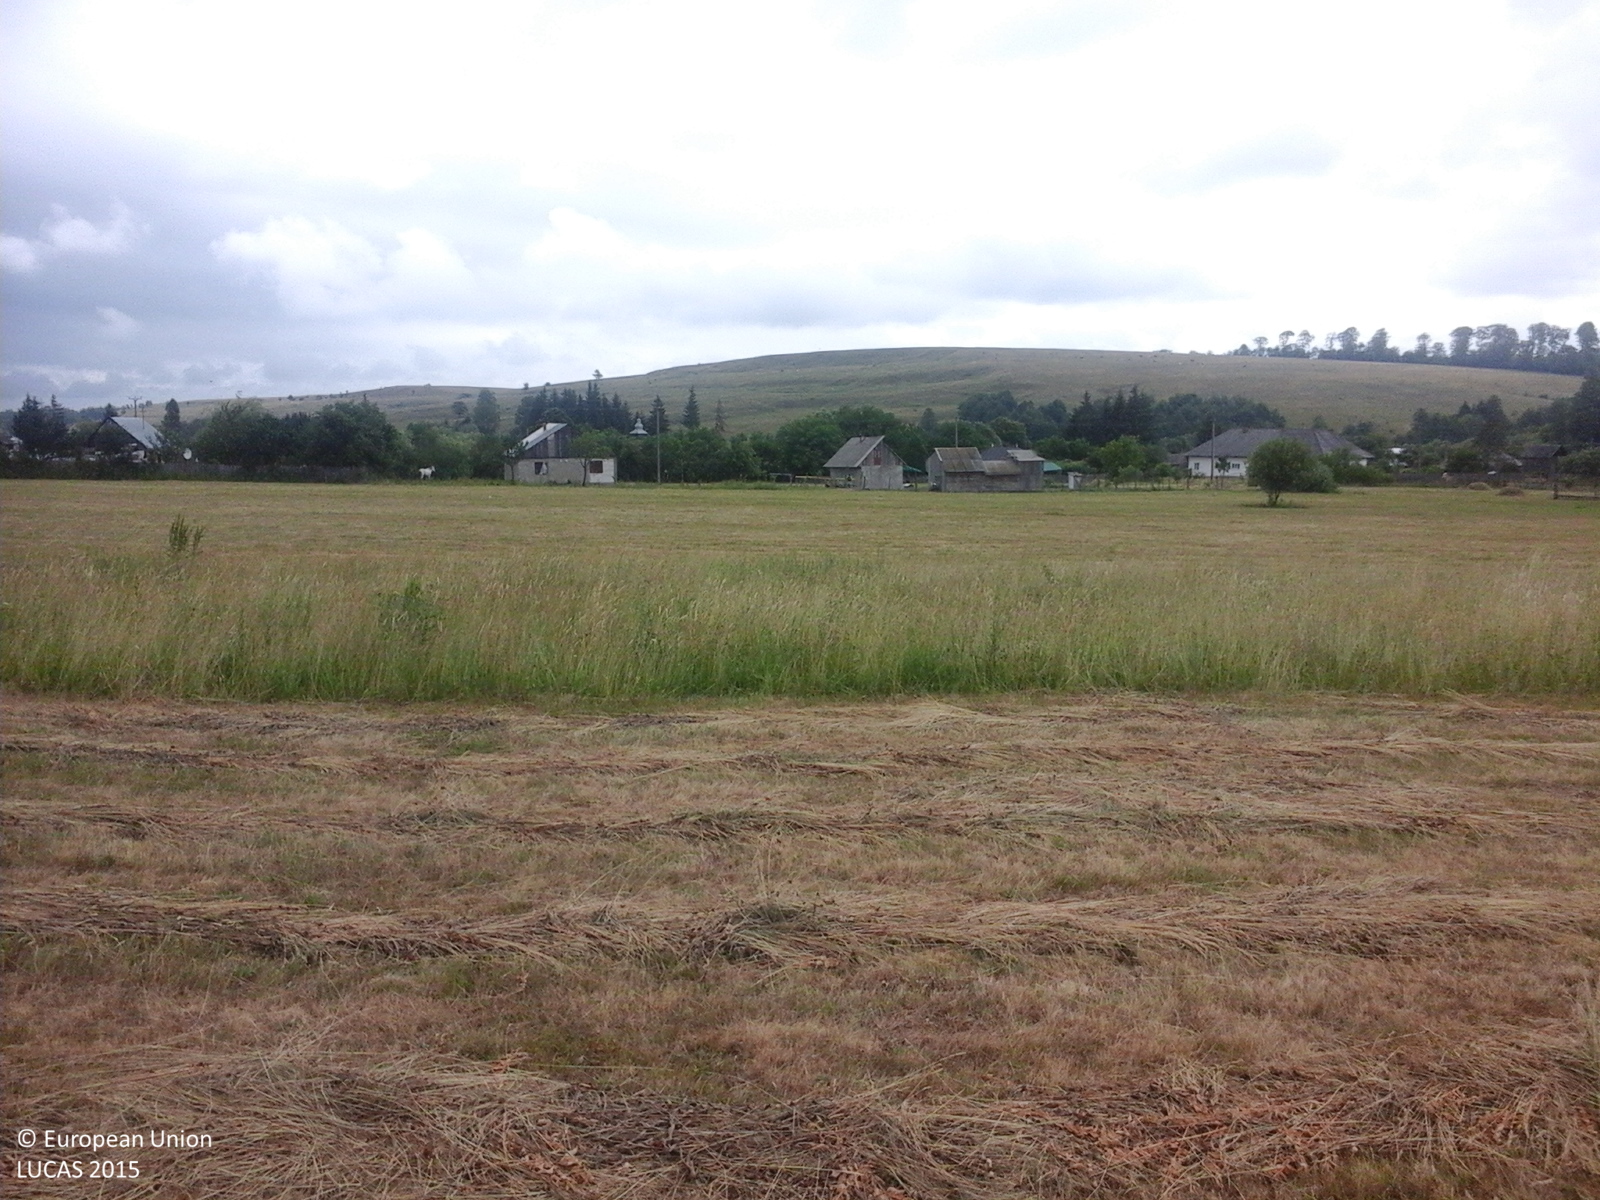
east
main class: Grassland
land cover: Grassland without tree/shrub cover
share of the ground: < 10 %
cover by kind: herbaceous plants 100 %
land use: Agriculture (excluding fallow land and kitchen gardens)
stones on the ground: < 10 %
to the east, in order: Grassland without tree/shrub cover; Lucerne; Grassland without tree/shrub cover; Lines of trees; Grassland without tree/shrub cover; Electric lines; Grassland without tree/shrub cover; Other fruit trees and berries; Broadleaved woodland; Ditches and canals; Broadleaved woodland; Grassland without tree/shrub cover
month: June
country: RO
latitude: 47.2921
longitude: 26.3072
